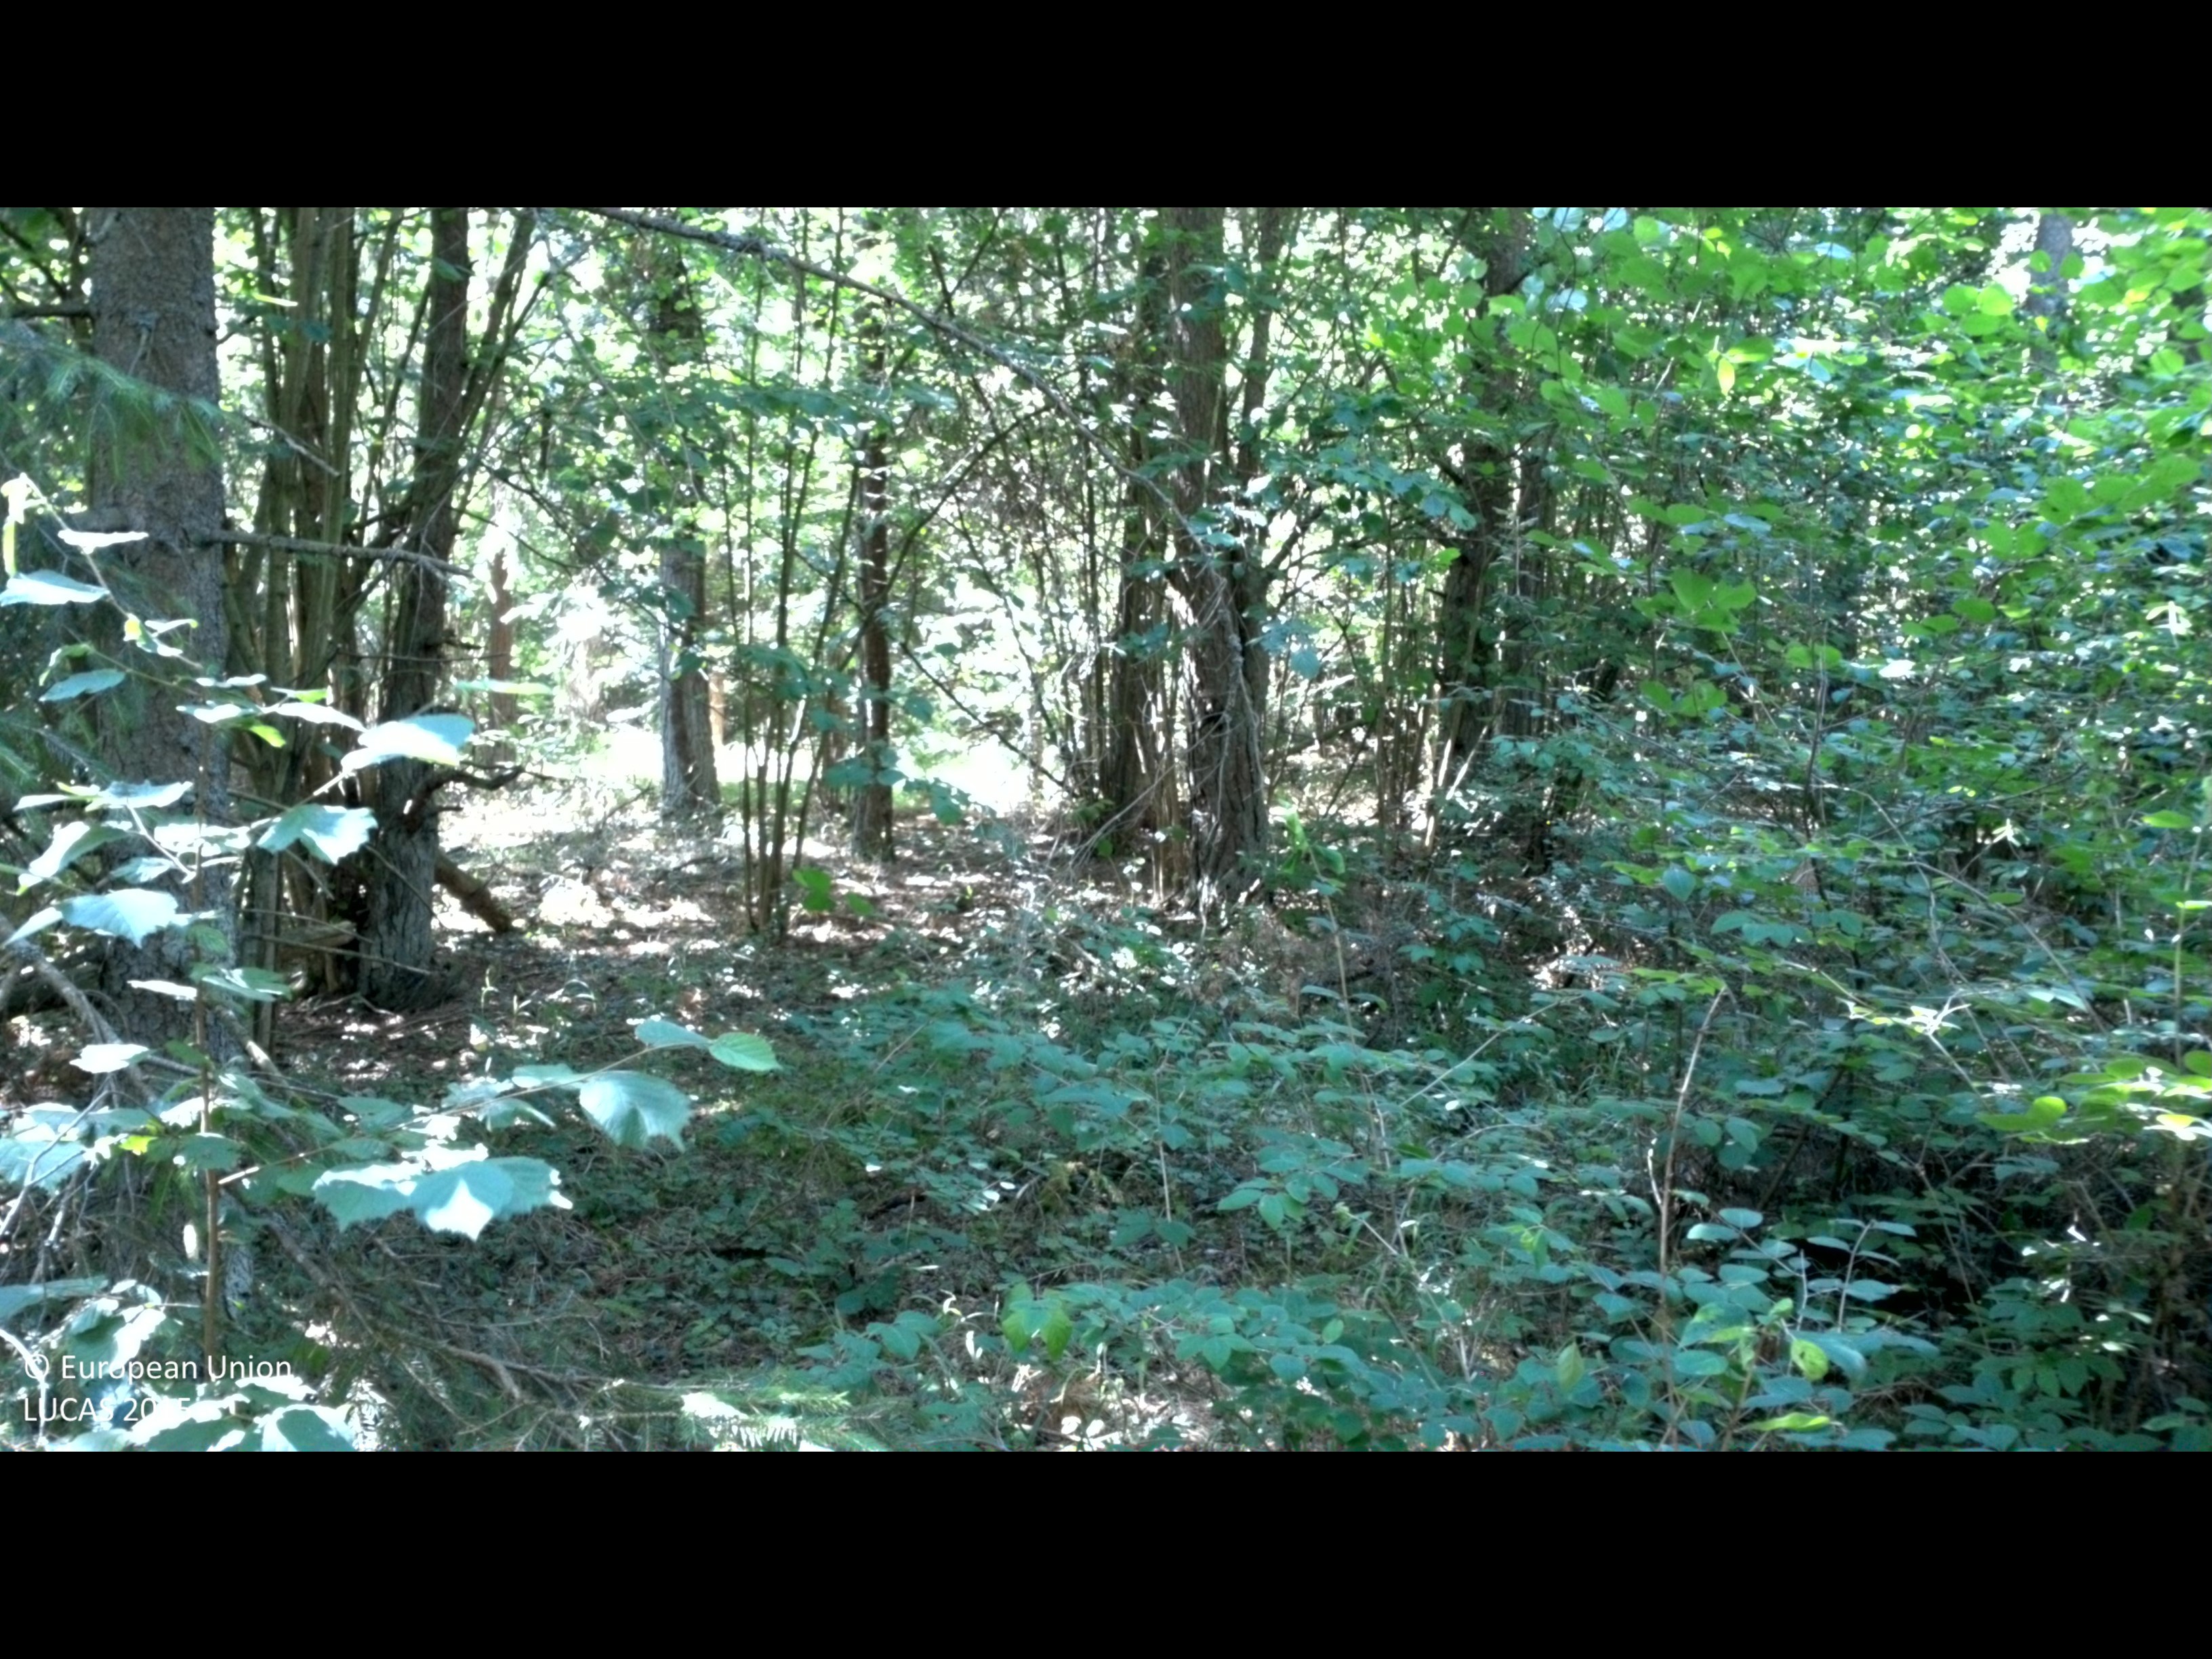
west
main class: Woodland
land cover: Pine dominated coniferous woodland
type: boreal forest
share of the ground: 50 - 75 %
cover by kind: coniferous forest trees 65 %, shrubs 30 %, herbaceous plants 5 %
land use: Forestry
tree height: > 5 m
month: July
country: SE
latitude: 56.5954
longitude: 16.5978
